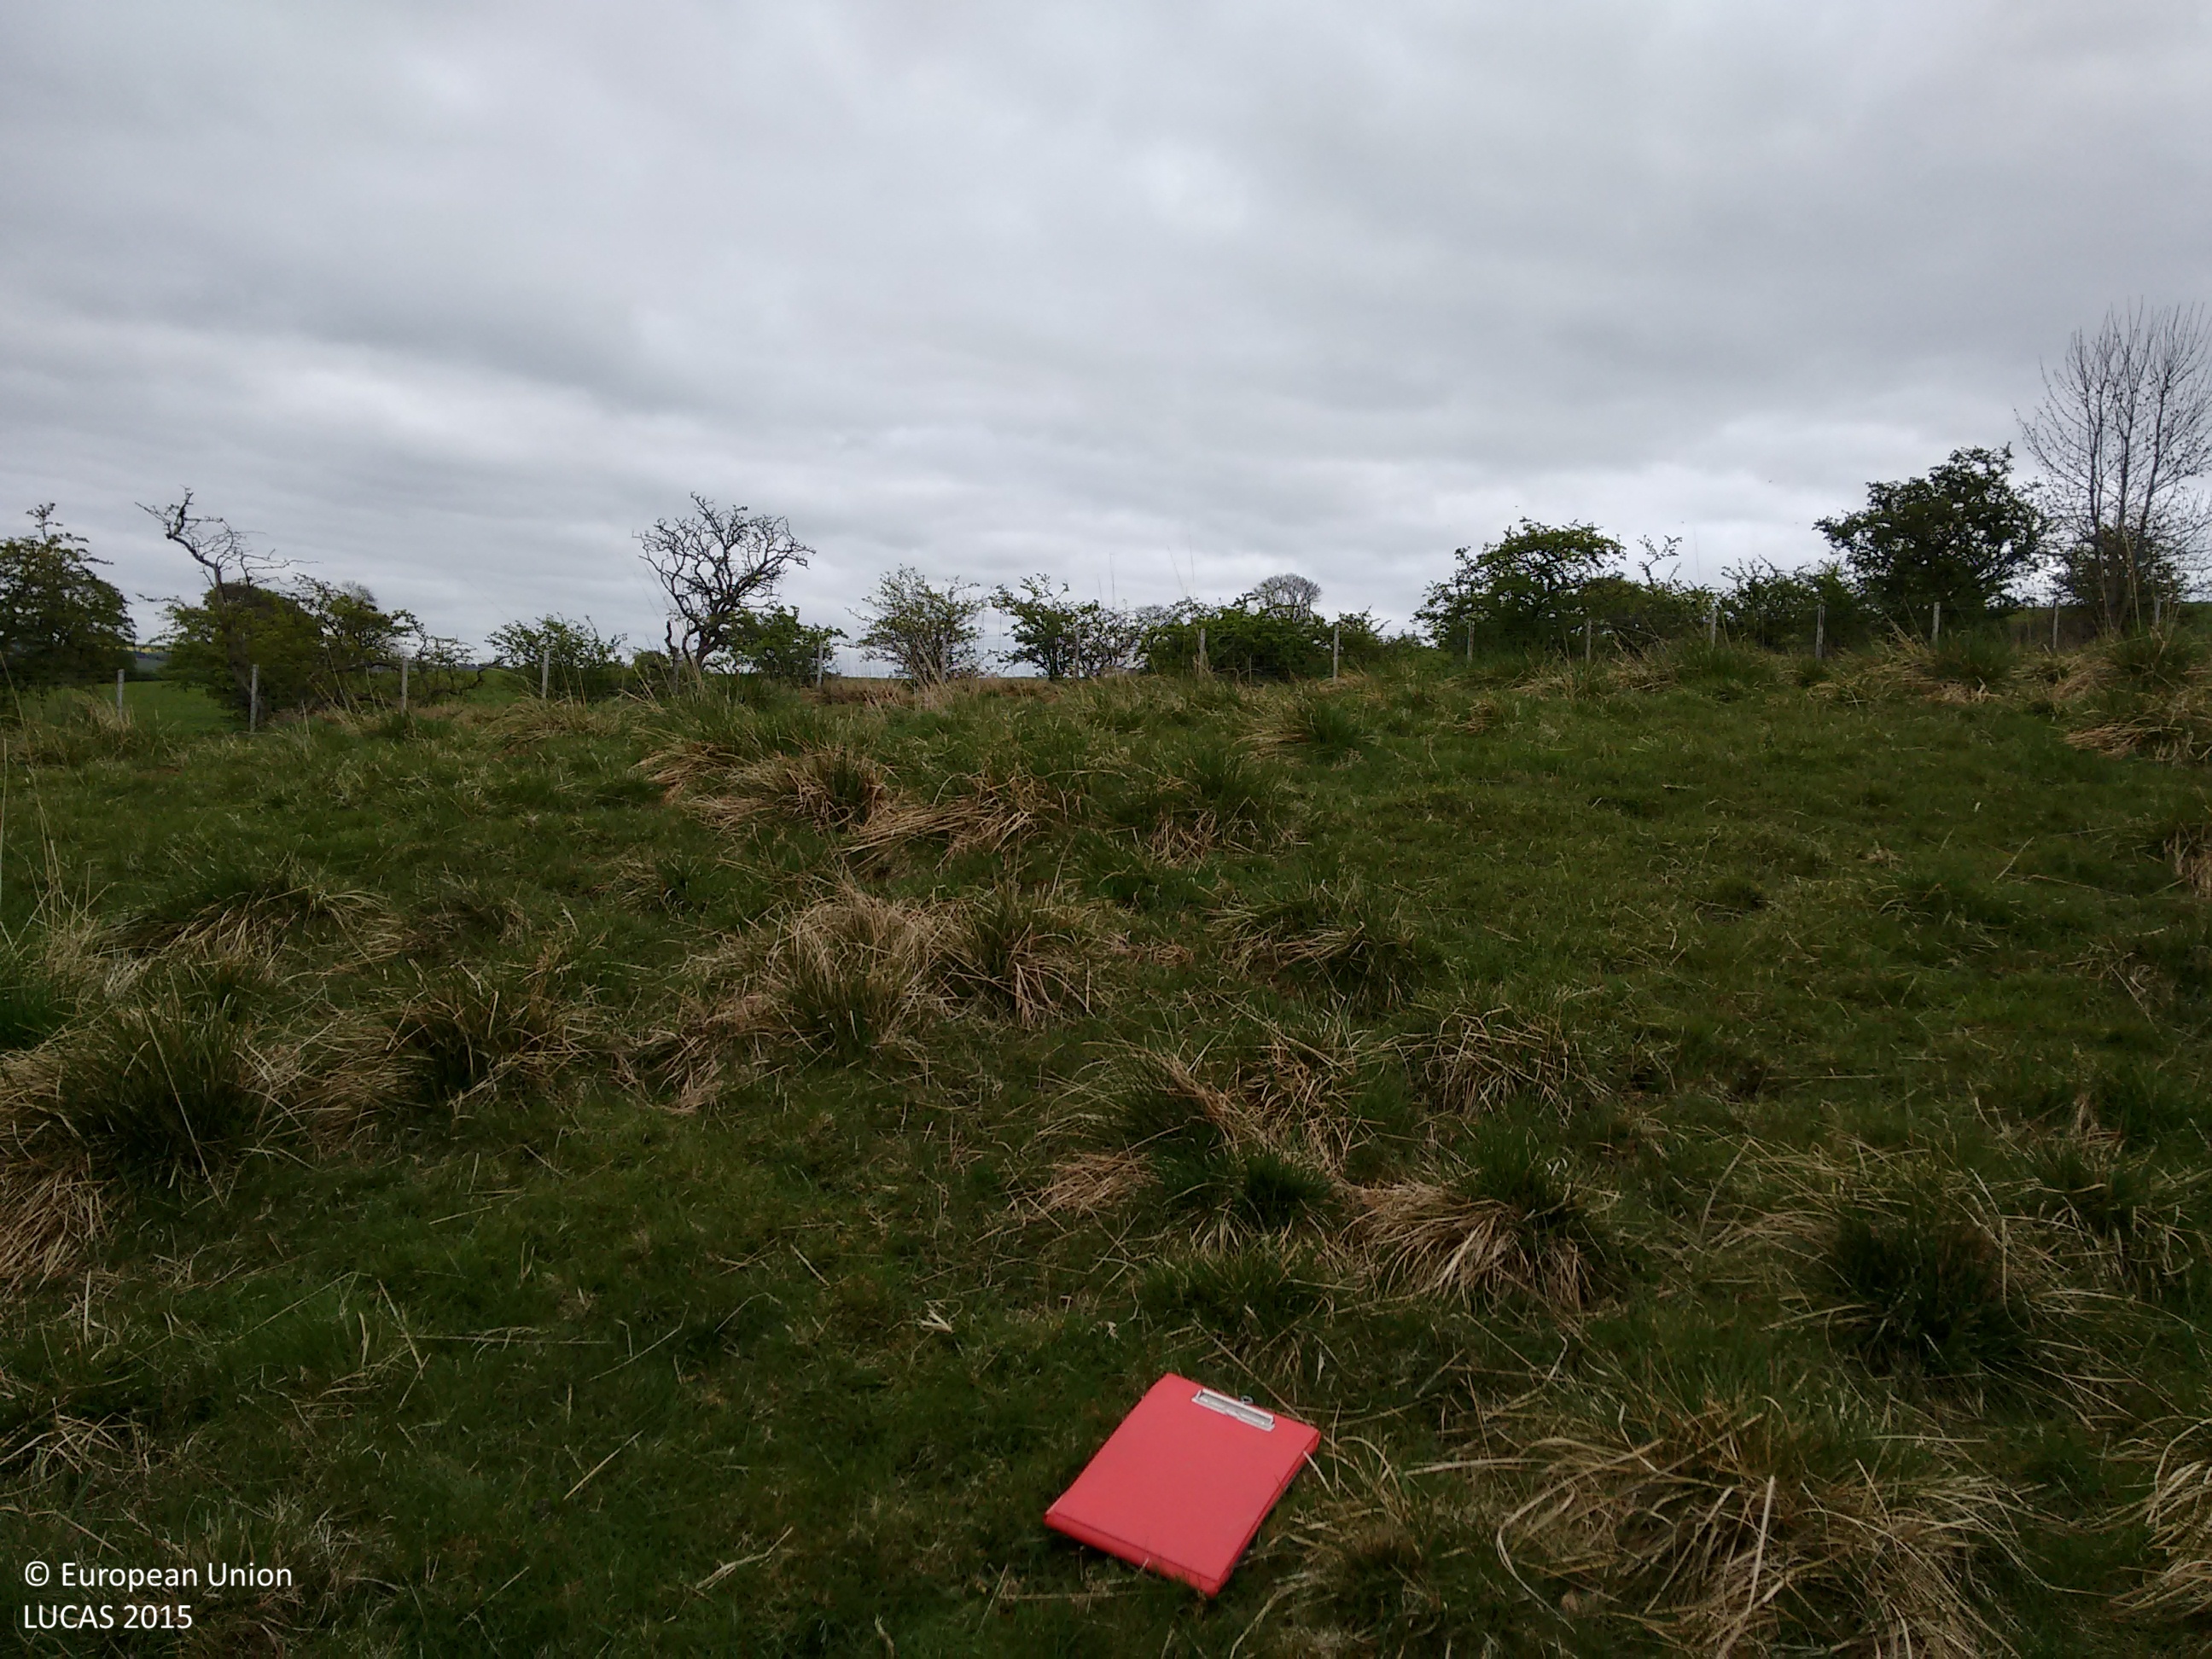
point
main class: Grassland
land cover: Grassland without tree/shrub cover
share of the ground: > 75 %
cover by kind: herbaceous plants 100 %
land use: Agriculture (excluding fallow land and kitchen gardens)
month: May
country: GB
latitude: 55.0315
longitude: -2.0870
